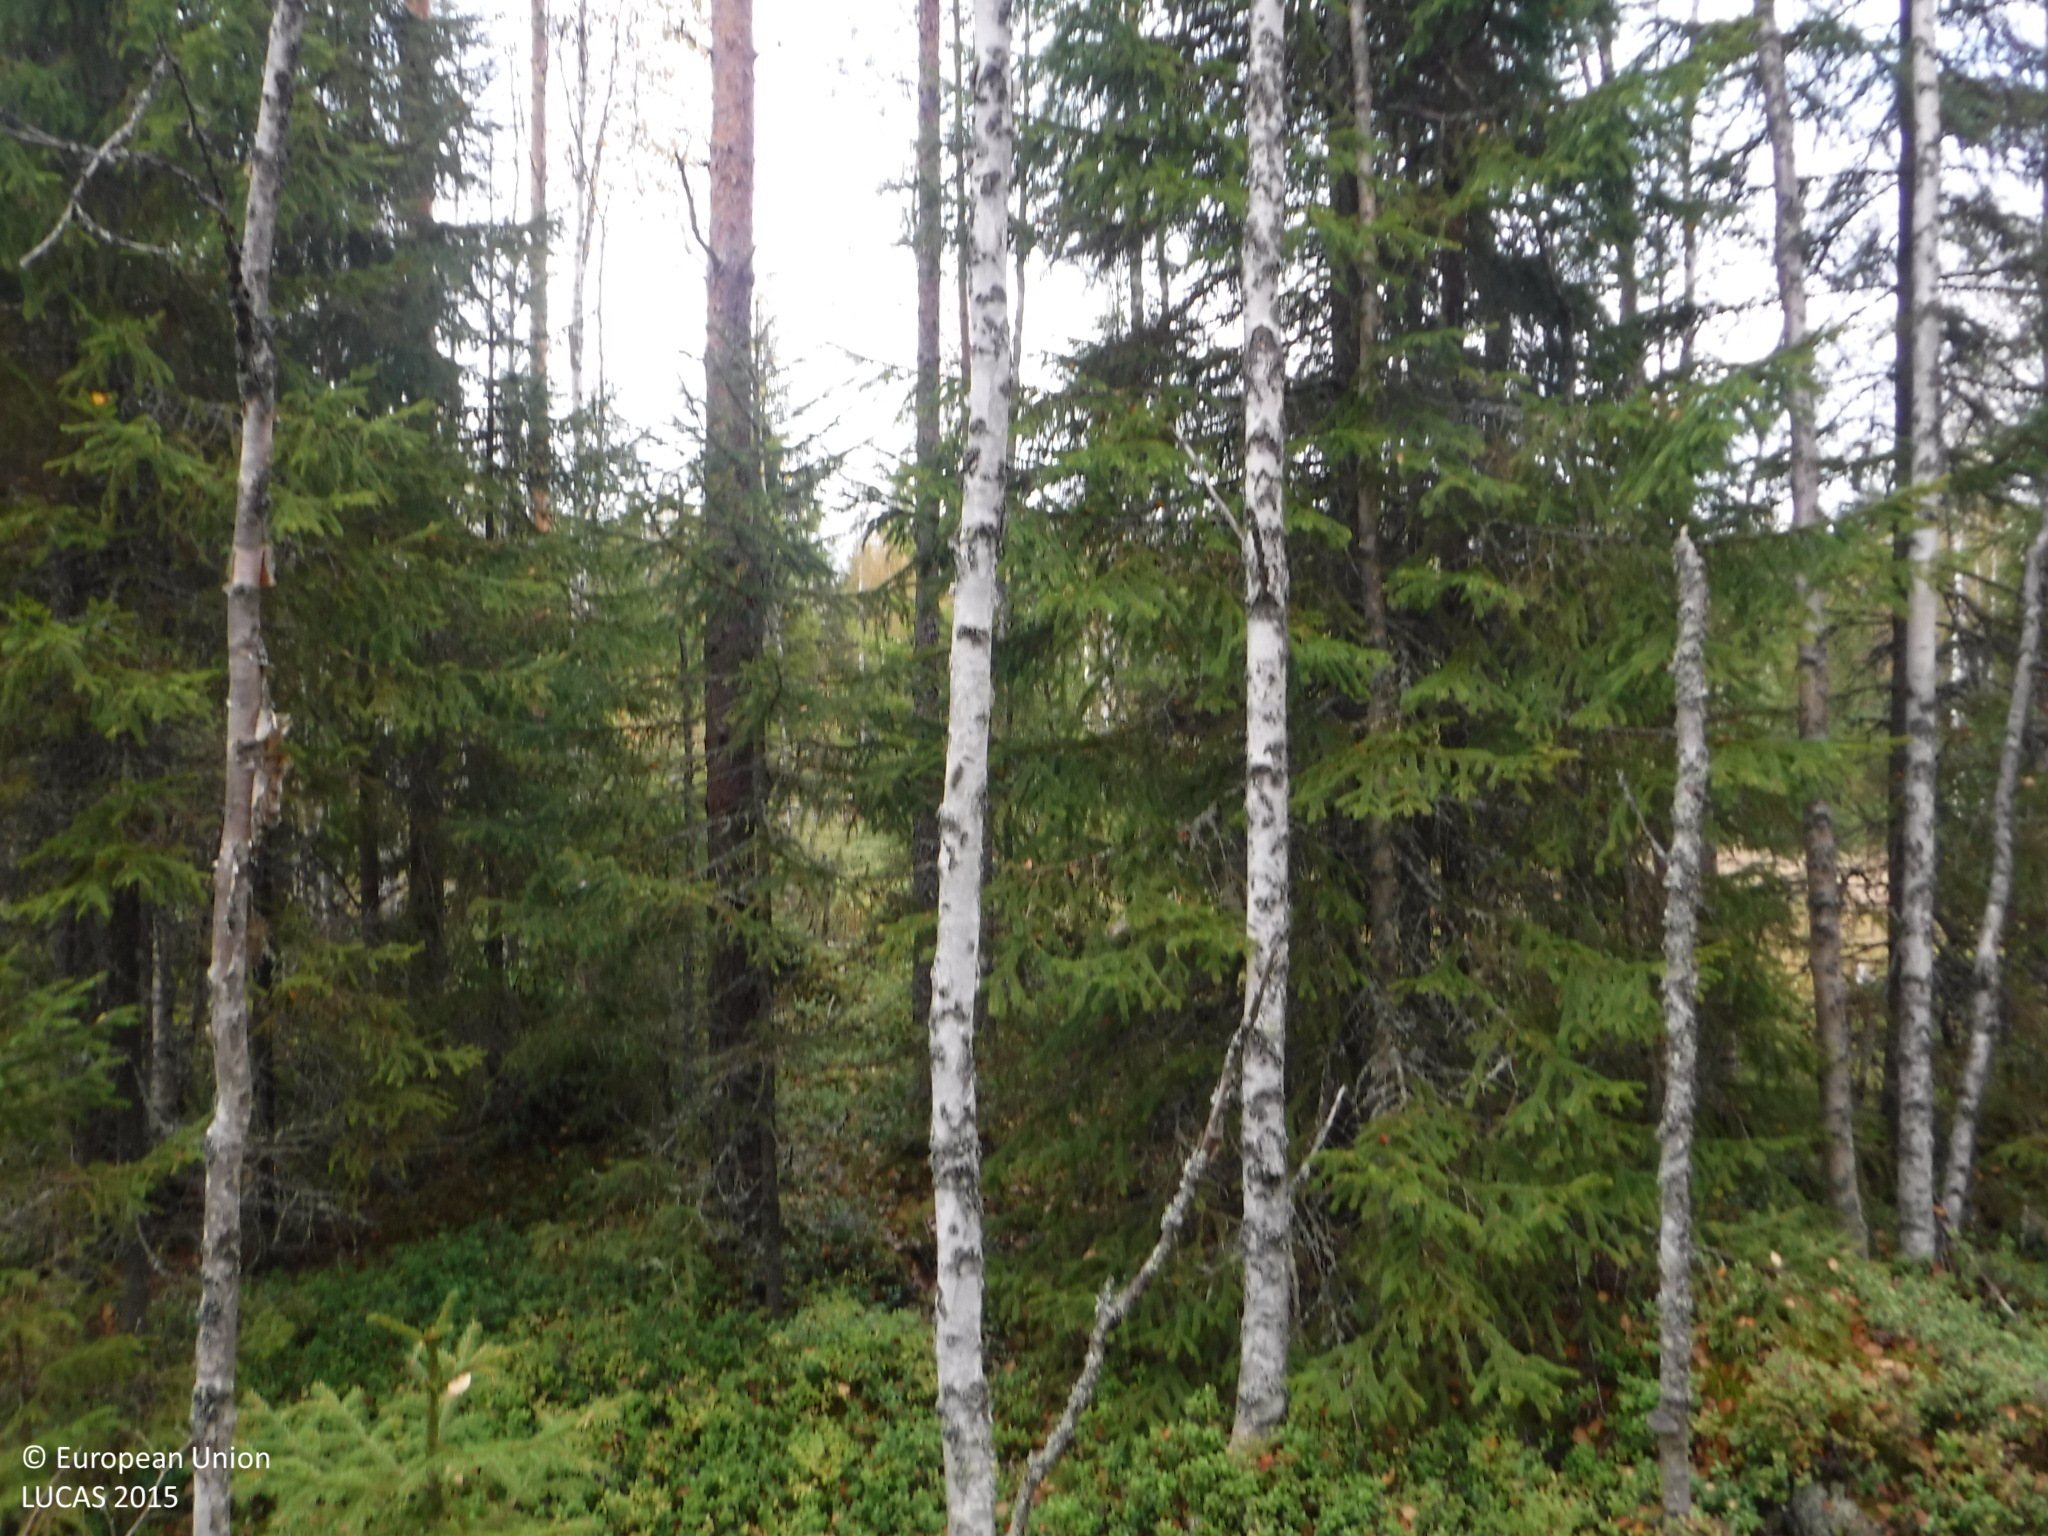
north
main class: Woodland
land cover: Other mixed woodland
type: boreal forest
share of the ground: 50 - 75 %
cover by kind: coniferous forest trees 25 %, broadleaved forest trees 25 %, shrubs 25 %, lichens and mosses 25 %
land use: Forestry
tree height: > 5 m
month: September
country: FI
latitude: 62.0356
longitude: 23.3194
